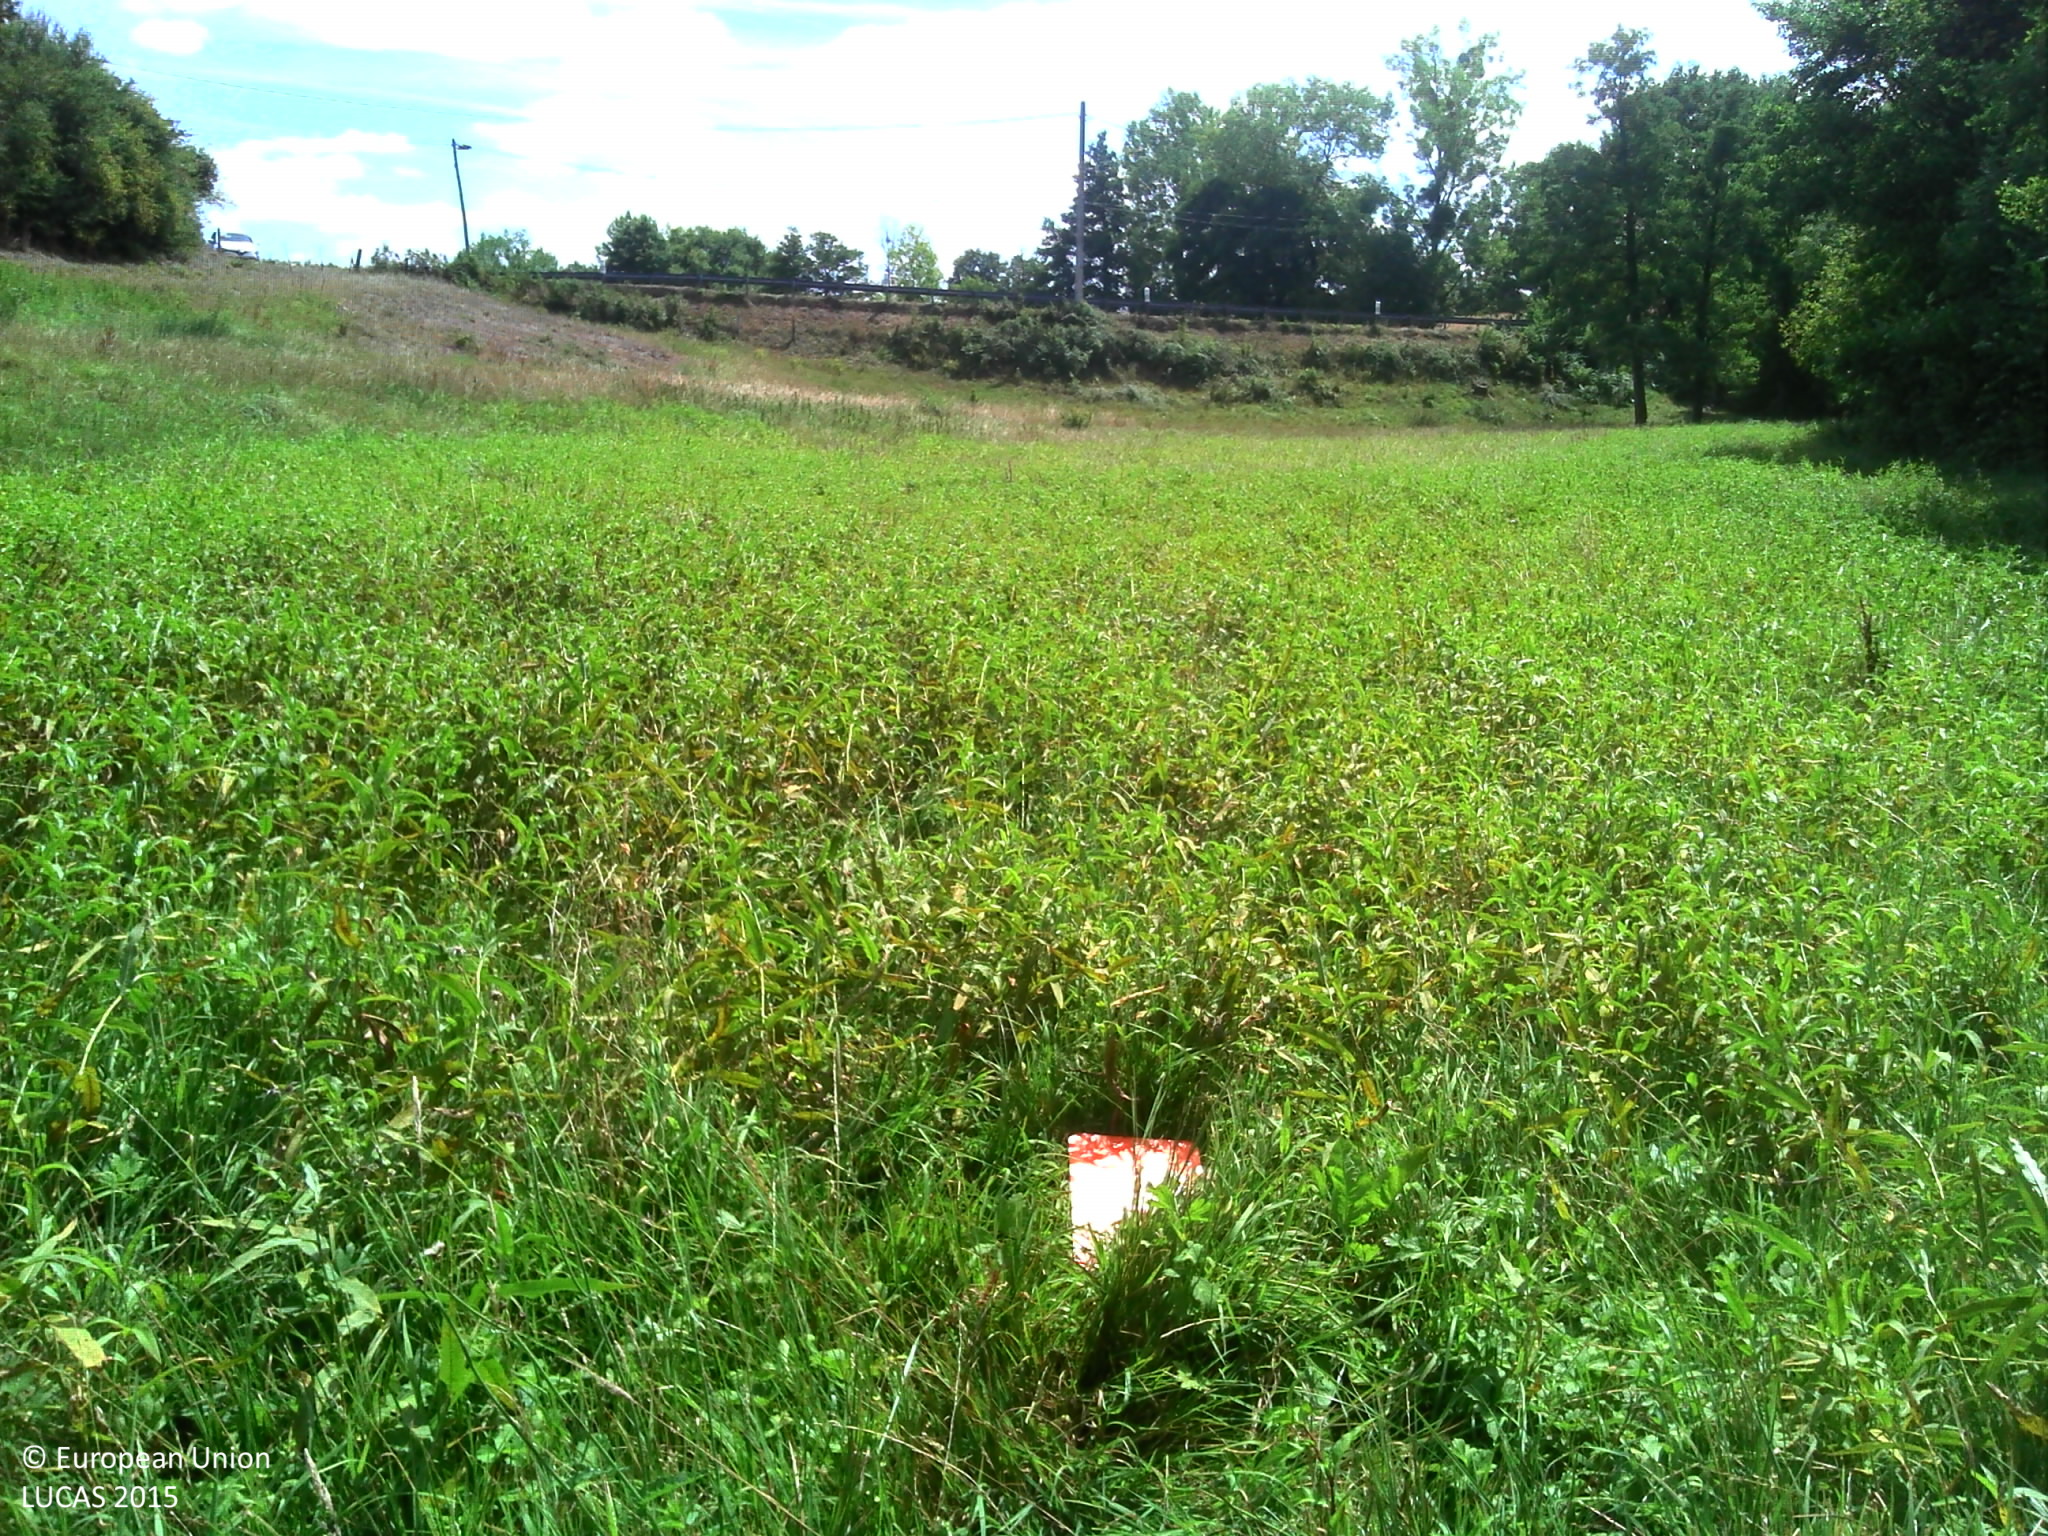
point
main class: Grassland
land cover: Grassland without tree/shrub cover
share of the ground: > 75 %
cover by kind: herbaceous plants 100 %
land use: Agriculture (excluding fallow land and kitchen gardens)
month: August
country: FR
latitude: 46.7834
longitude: -1.1556
